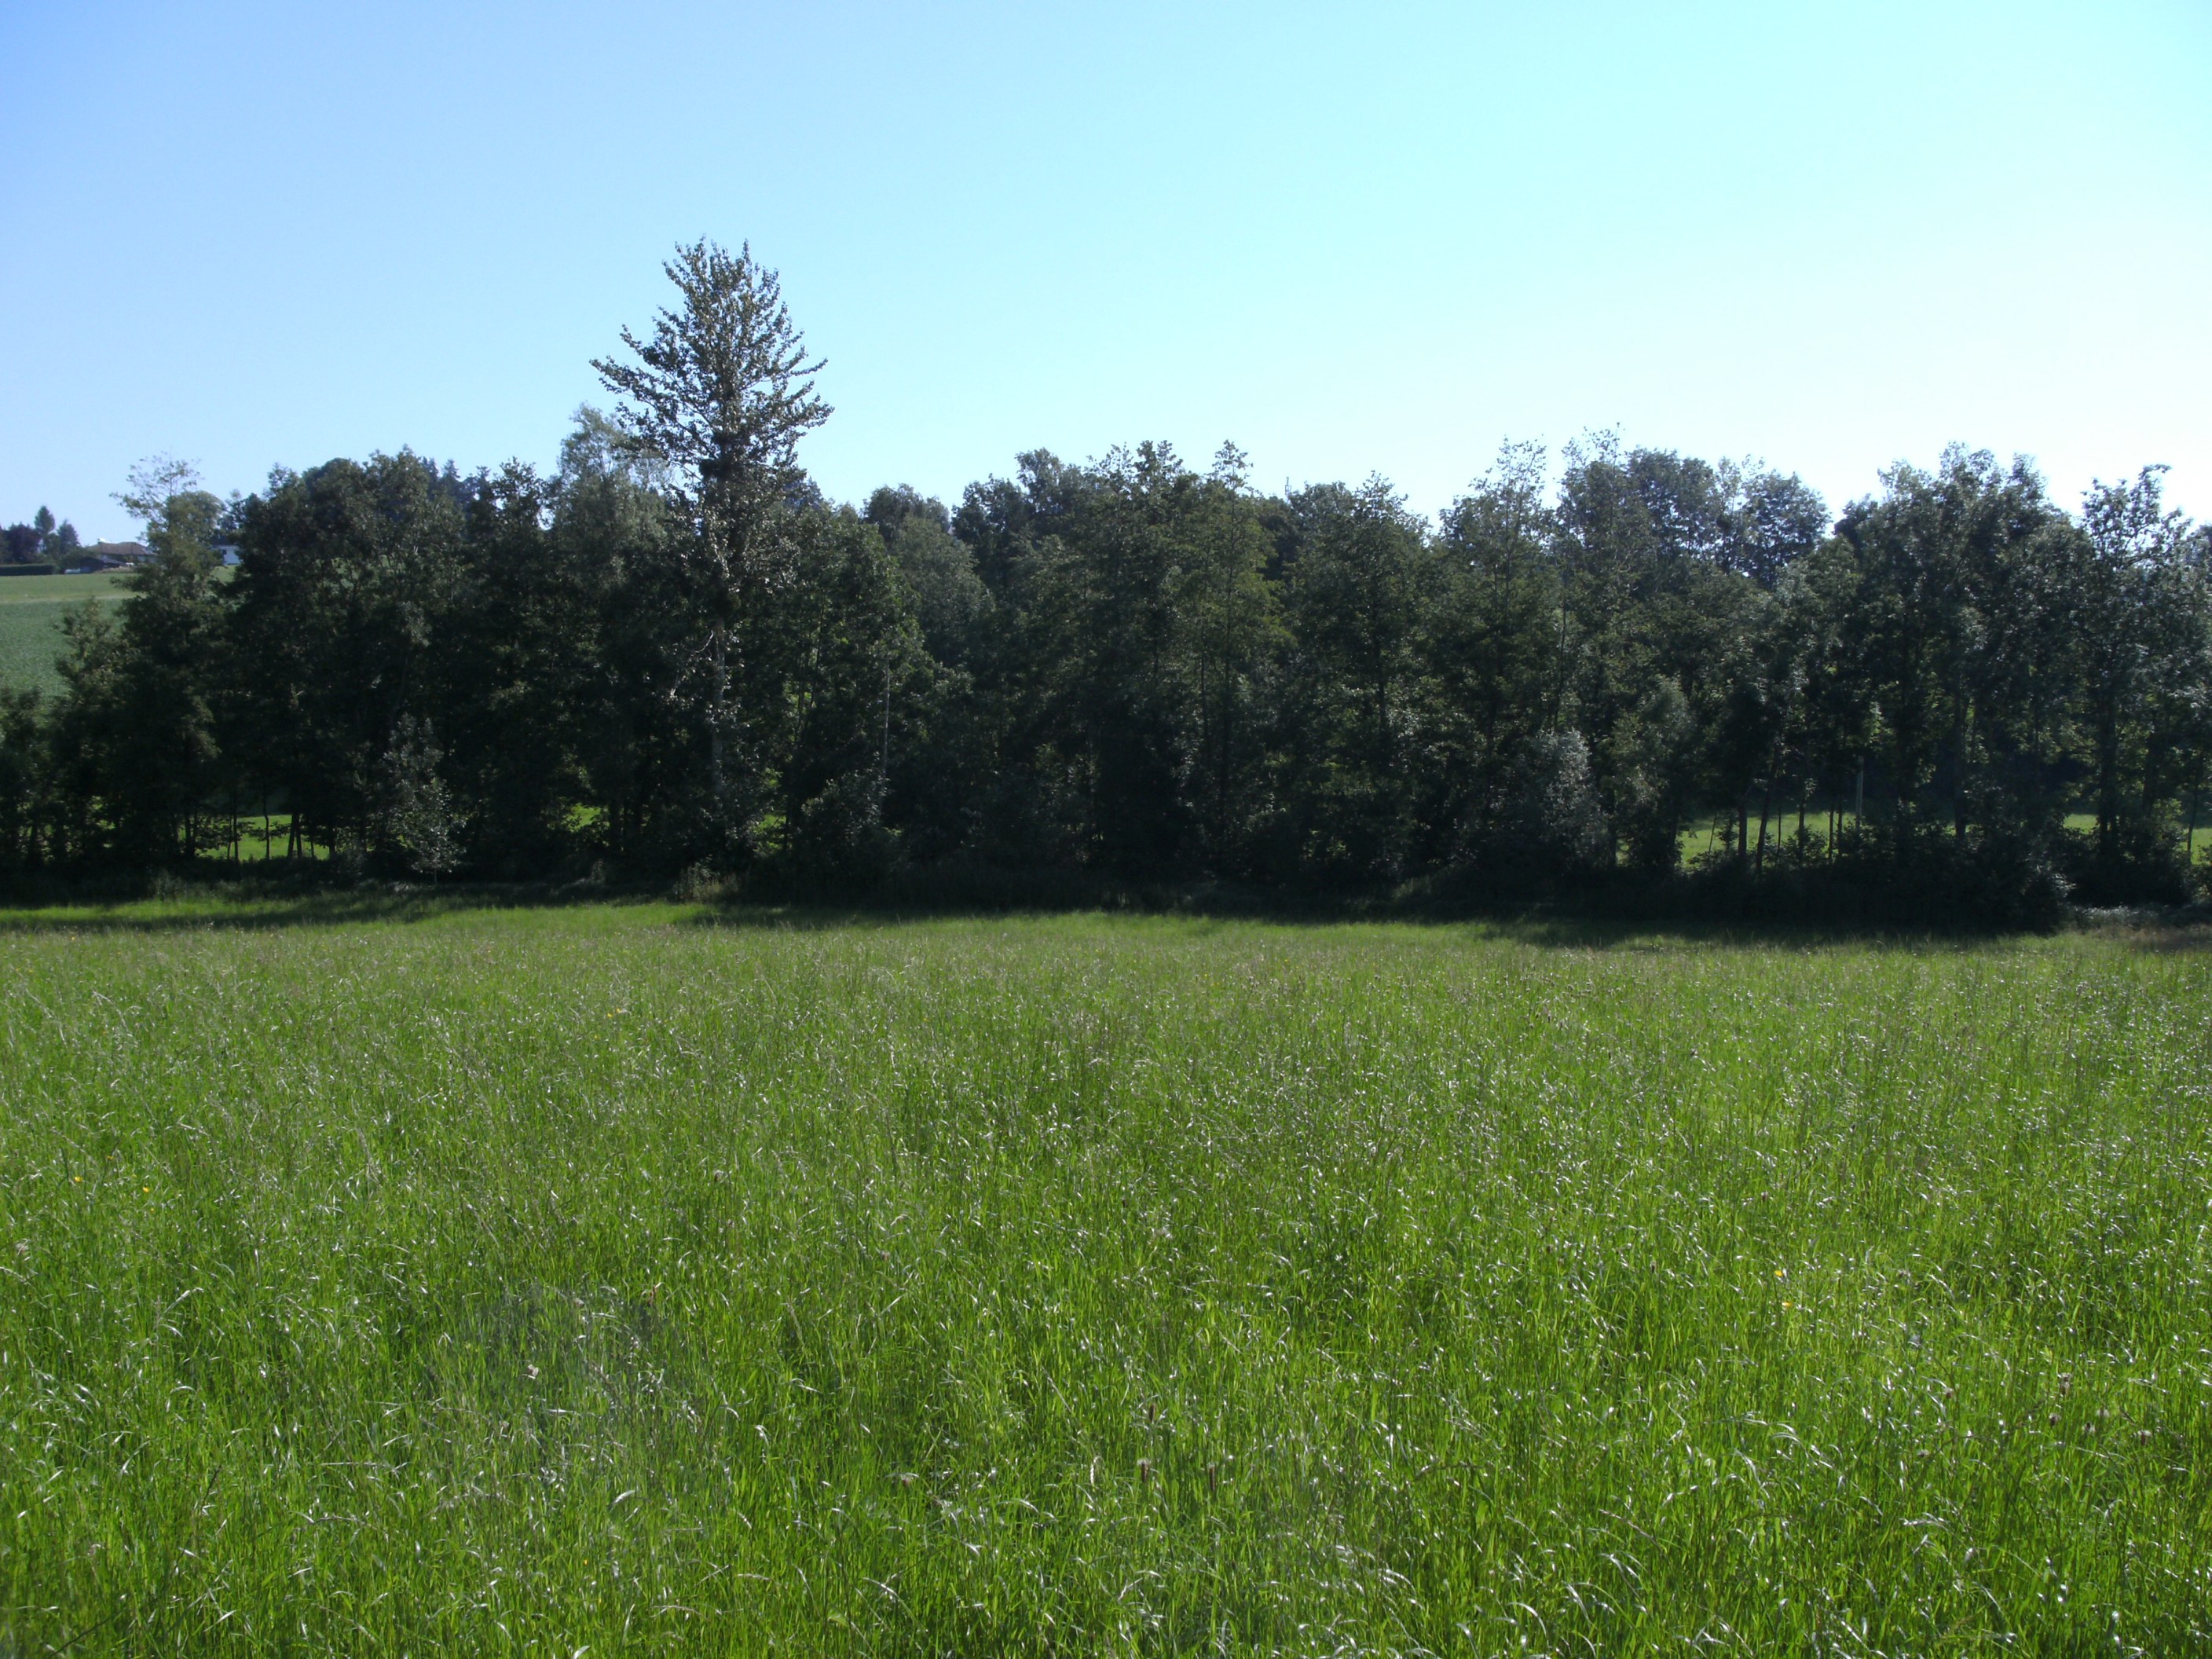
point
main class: Grassland
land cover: Grassland without tree/shrub cover
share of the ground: > 75 %
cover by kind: herbaceous plants 100 %
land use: Agriculture (excluding fallow land and kitchen gardens)
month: July
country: AT
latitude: 48.1480
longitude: 13.5611
